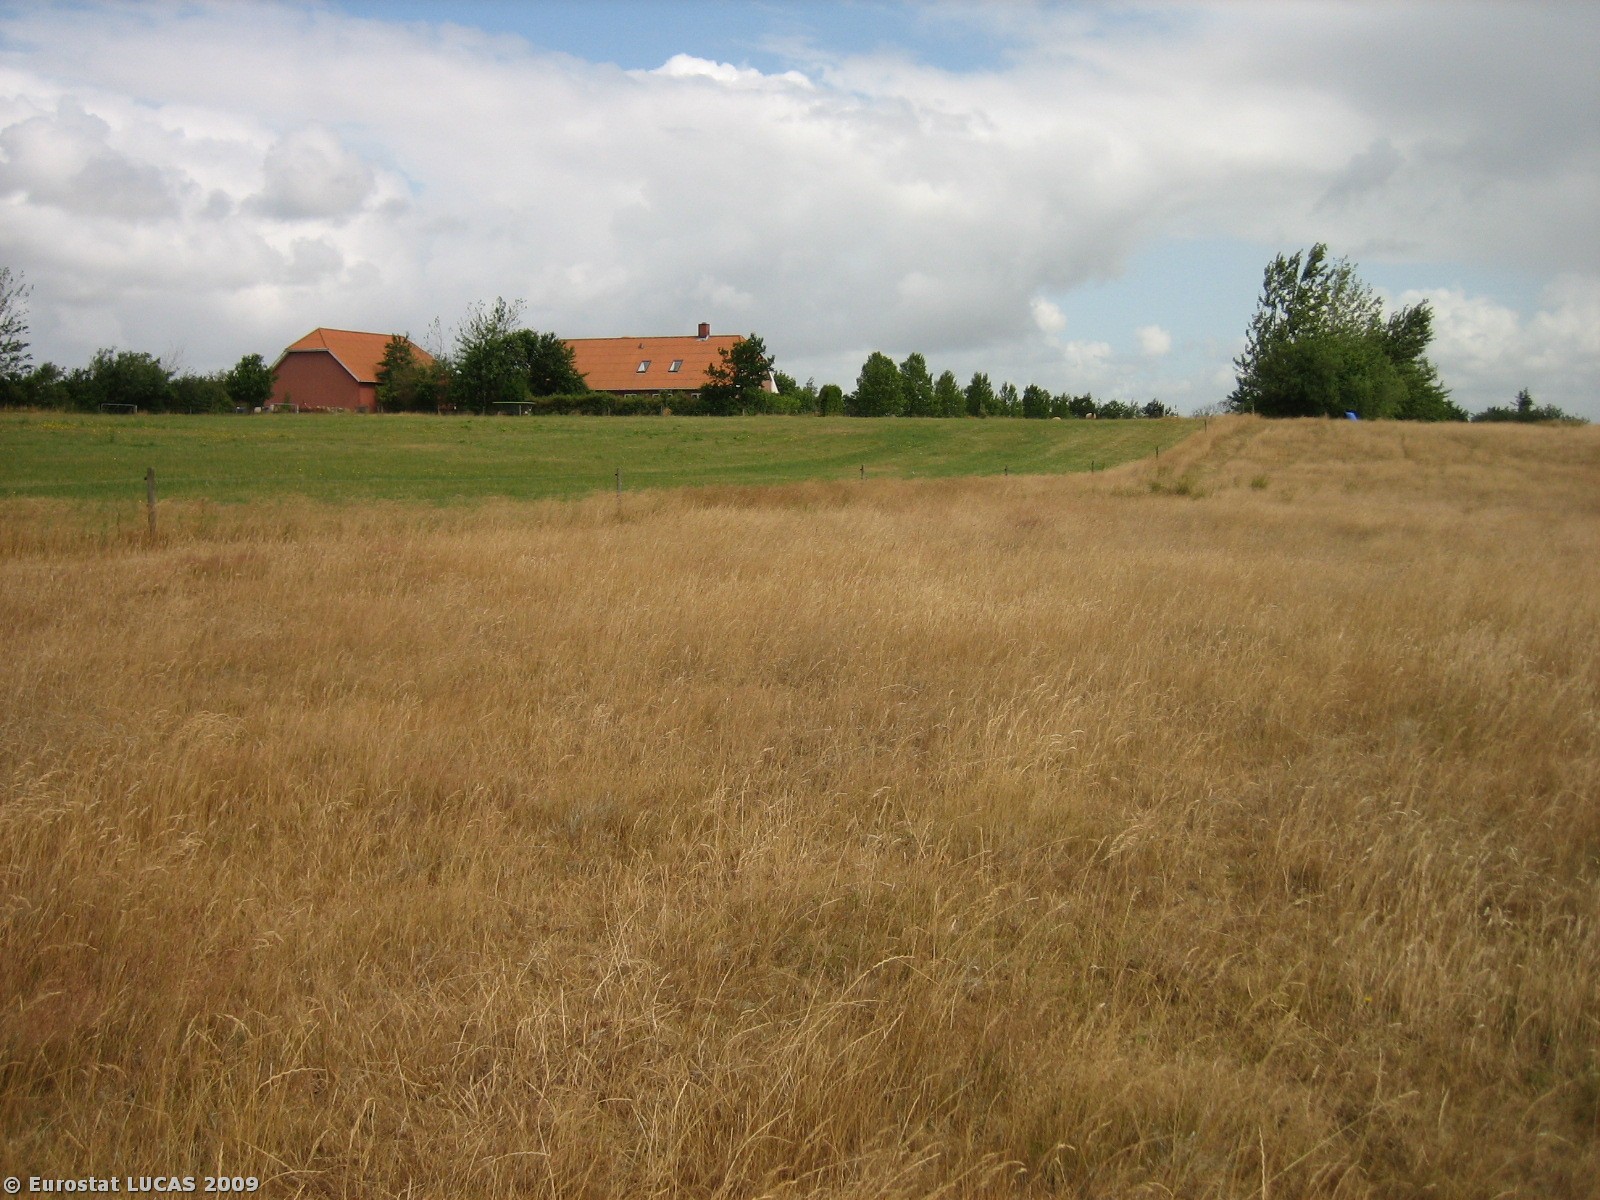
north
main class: Grassland
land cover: Grassland without tree/shrub cover
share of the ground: > 75 %
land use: Agriculture (excluding fallow land and kitchen gardens)
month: July
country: DK
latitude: 55.5661
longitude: 8.3681
